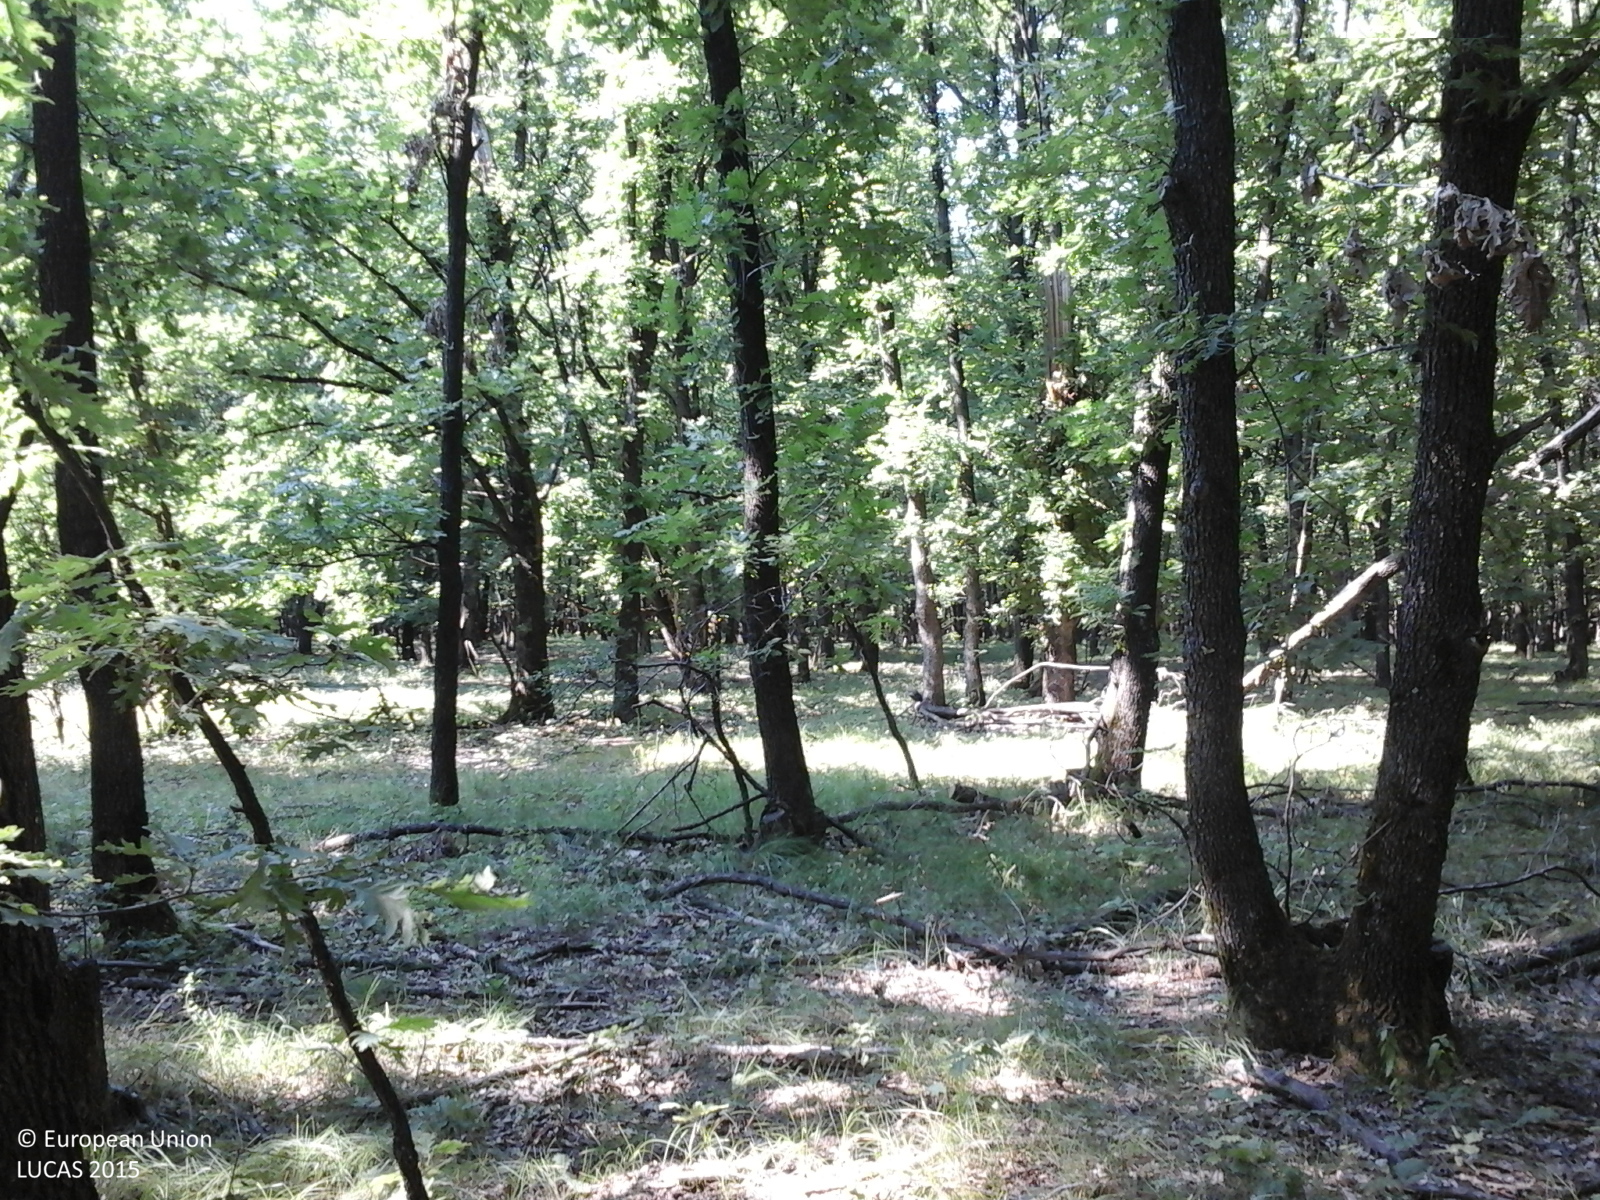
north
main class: Woodland
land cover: Broadleaved woodland
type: acidophilous oak and oak-birch forest
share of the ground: > 75 %
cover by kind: broadleaved forest trees 100 %
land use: Forestry
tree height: > 5 m
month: July
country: RO
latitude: 44.7022
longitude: 24.6012
